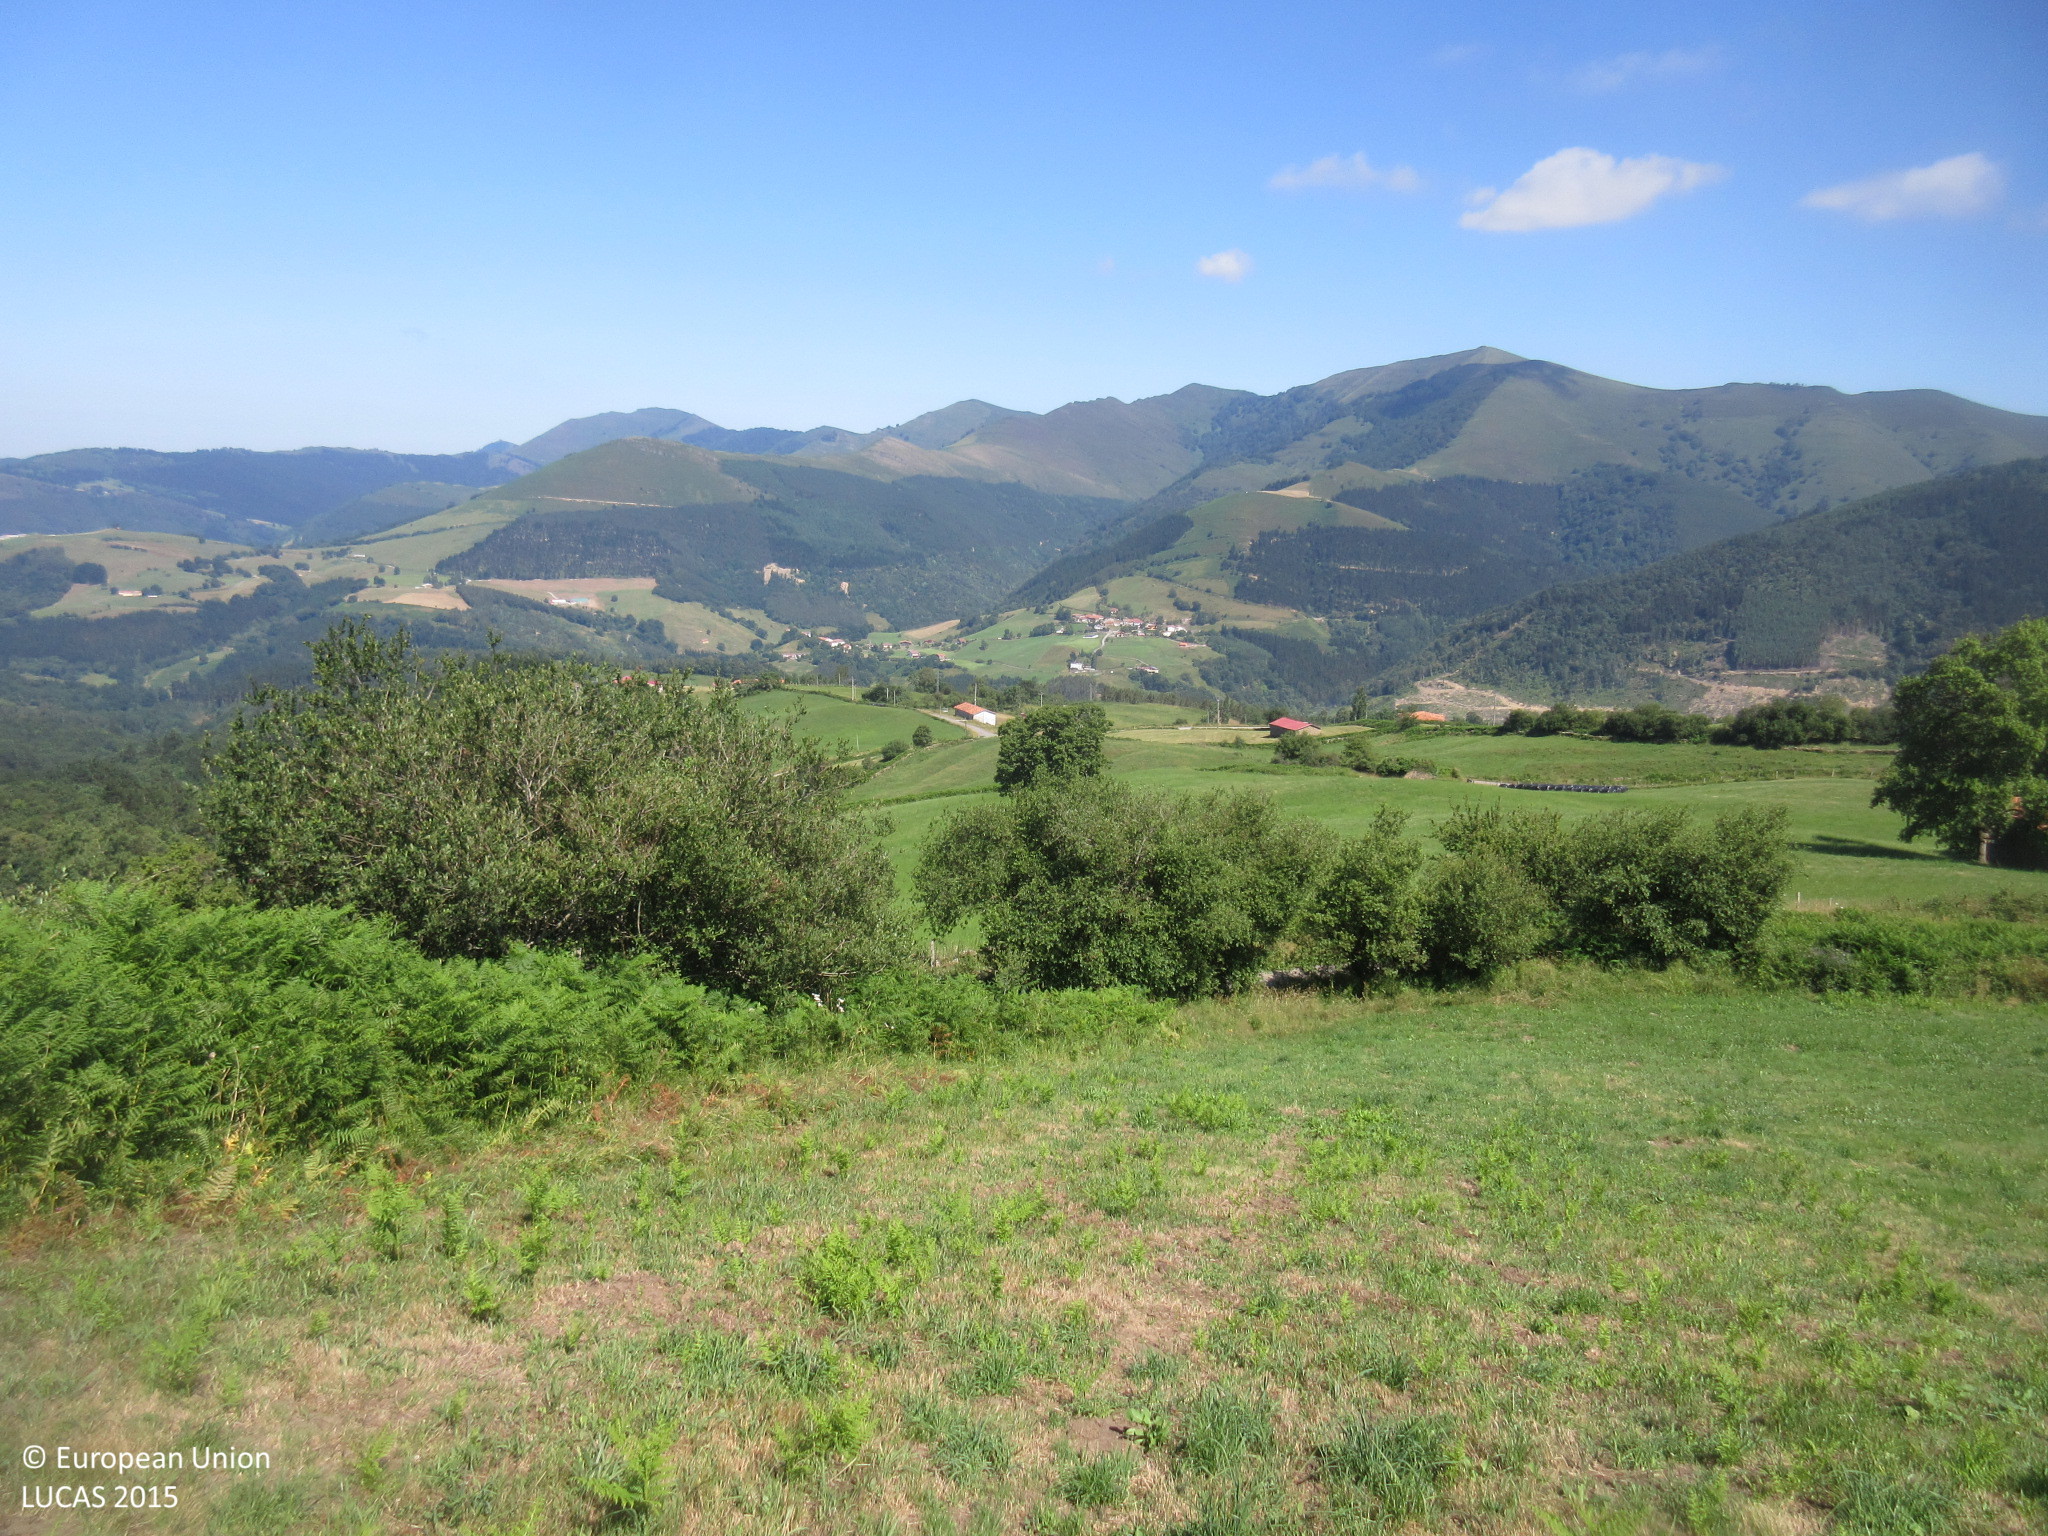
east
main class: Grassland
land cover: Grassland without tree/shrub cover
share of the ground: > 75 %
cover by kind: herbaceous plants 100 %
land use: Agriculture (excluding fallow land and kitchen gardens)
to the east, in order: Grassland without tree/shrub cover; Abandoned hedges; Grassland without tree/shrub cover; Fences; Abandoned hedges; Grass margins; Tracks; Abandoned hedges; Fences; Grassland without tree/shrub cover; Tracks; Fences; Dry stone walls; Grassland without tree/shrub cover; Shrubland without tree cover; Tracks; Shruby margins; Grassland without tree/shrub cover
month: July
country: ES
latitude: 43.1860
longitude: -3.3898
